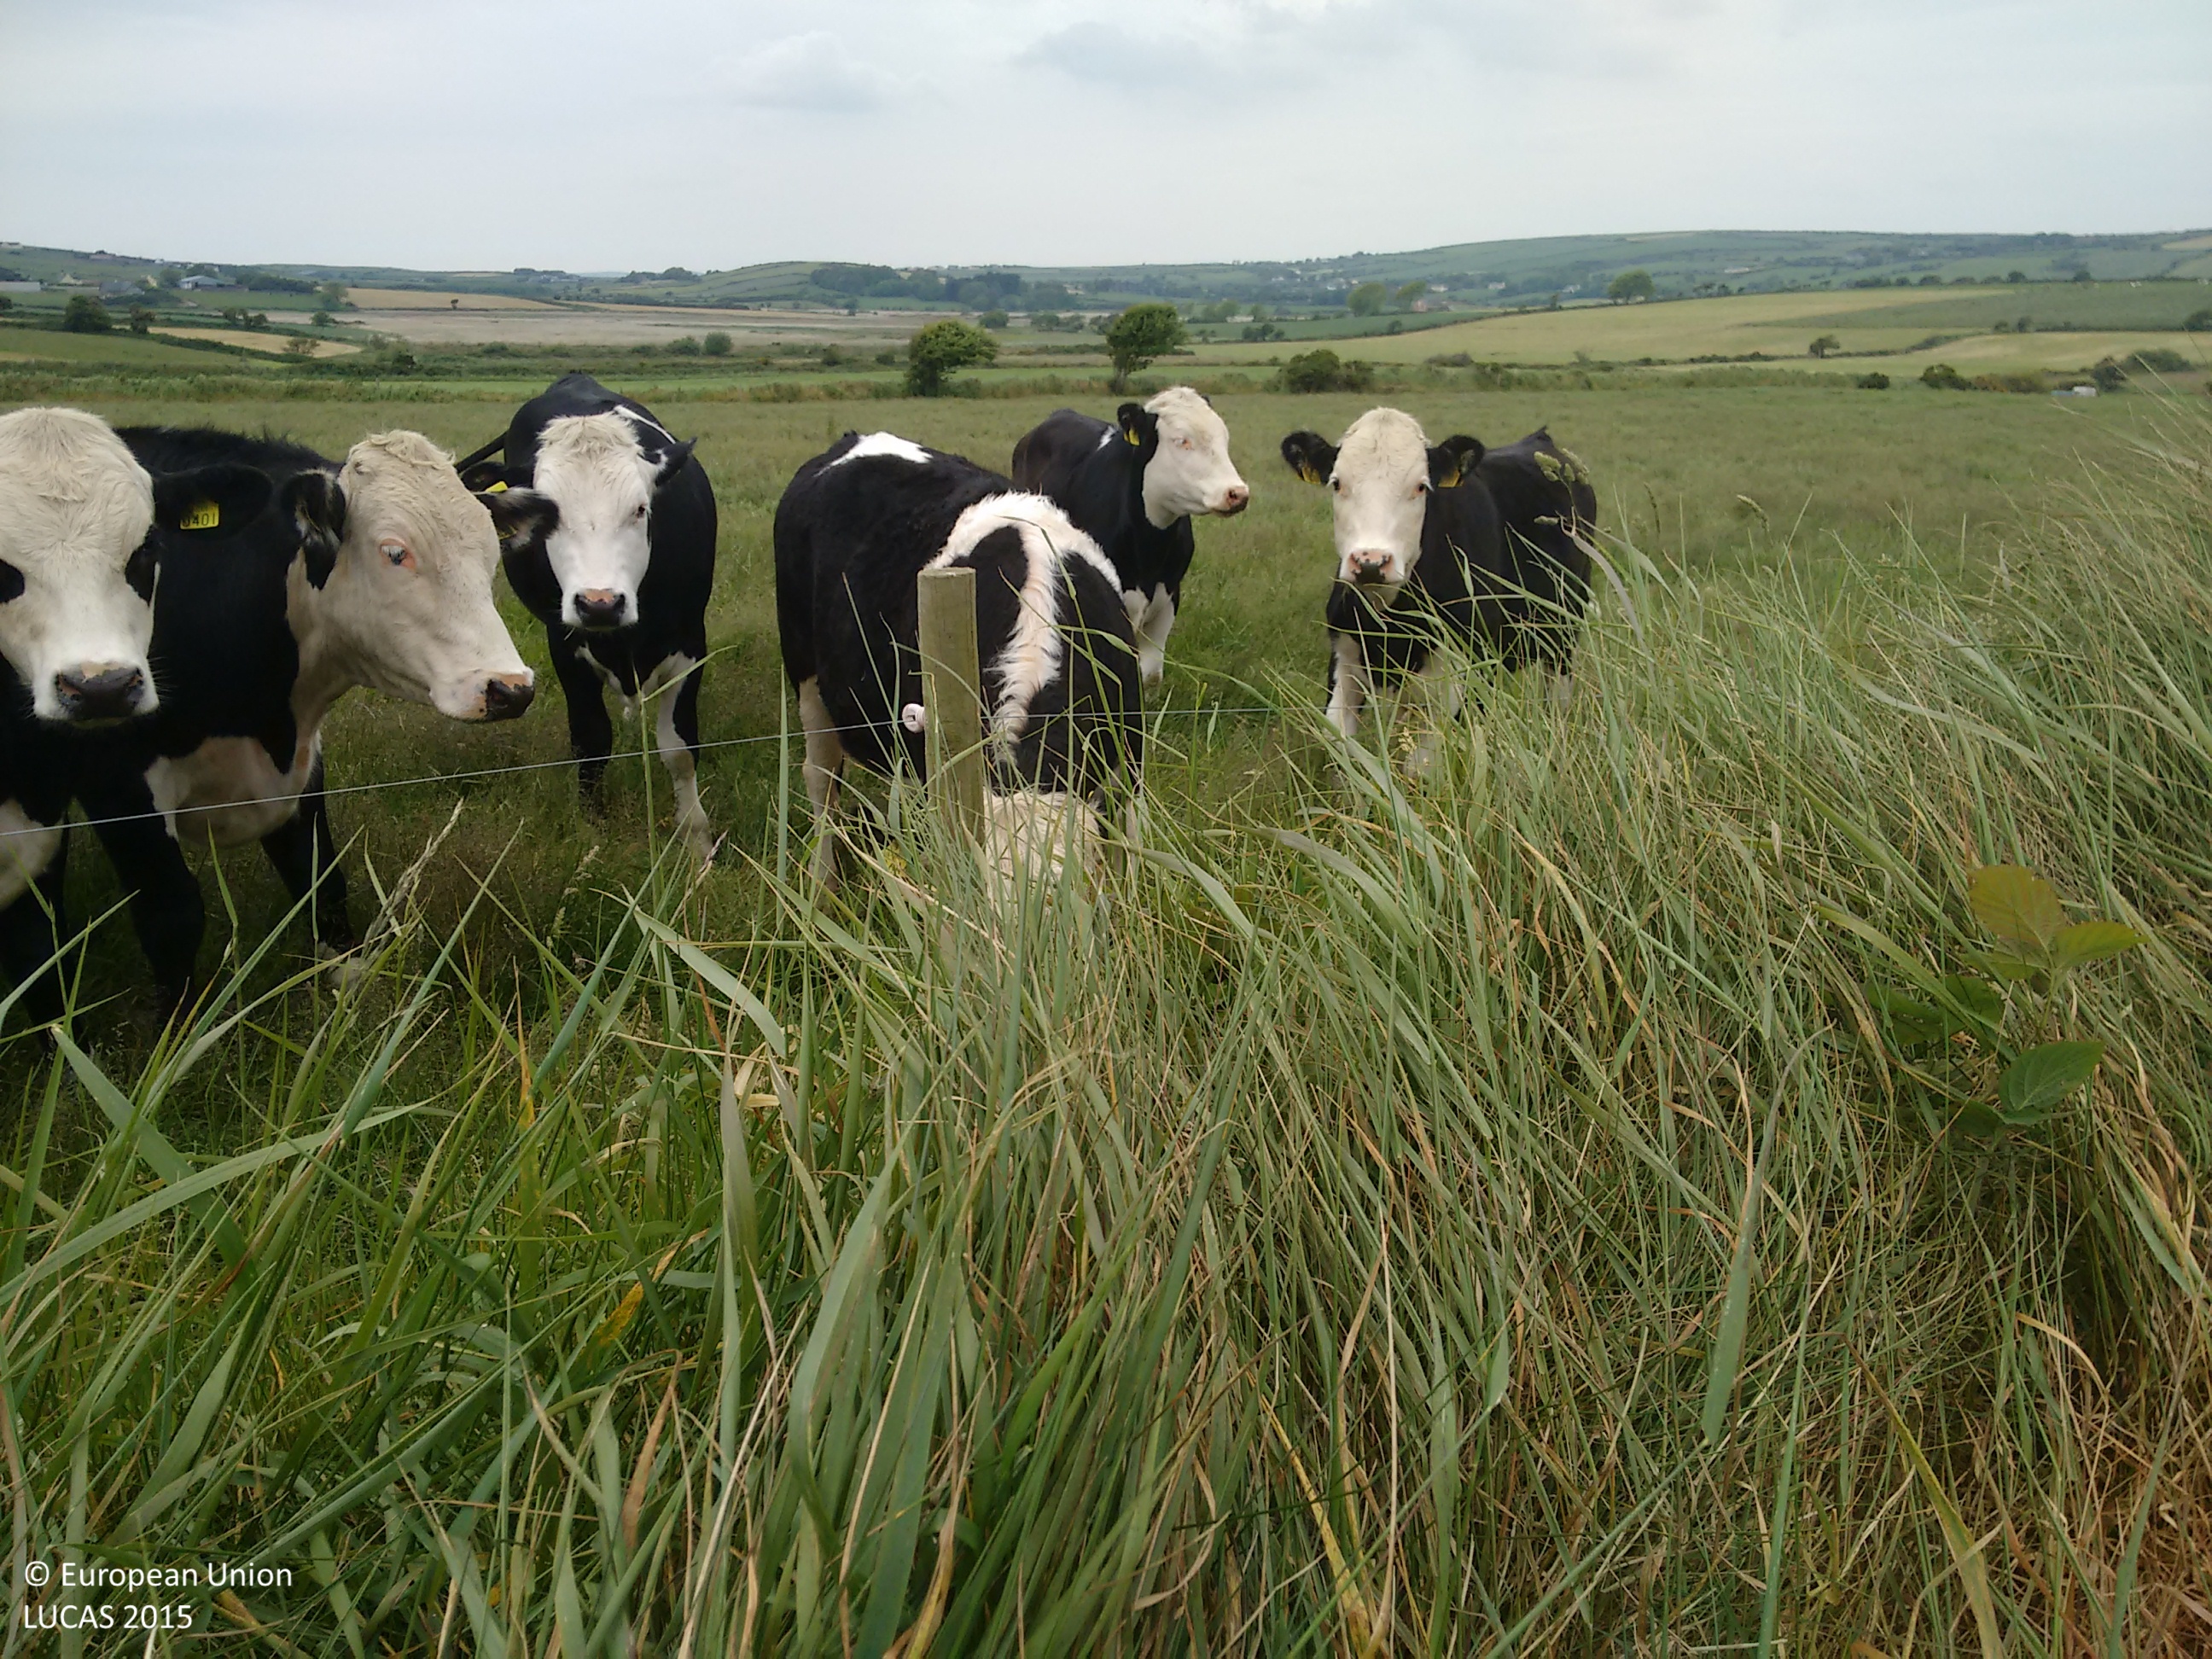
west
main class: Grassland
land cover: Grassland without tree/shrub cover
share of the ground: > 75 %
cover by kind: herbaceous plants 95 %, shrubs 5 %
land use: Agriculture (excluding fallow land and kitchen gardens)
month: June
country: IE
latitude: 51.6017
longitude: -8.7559
